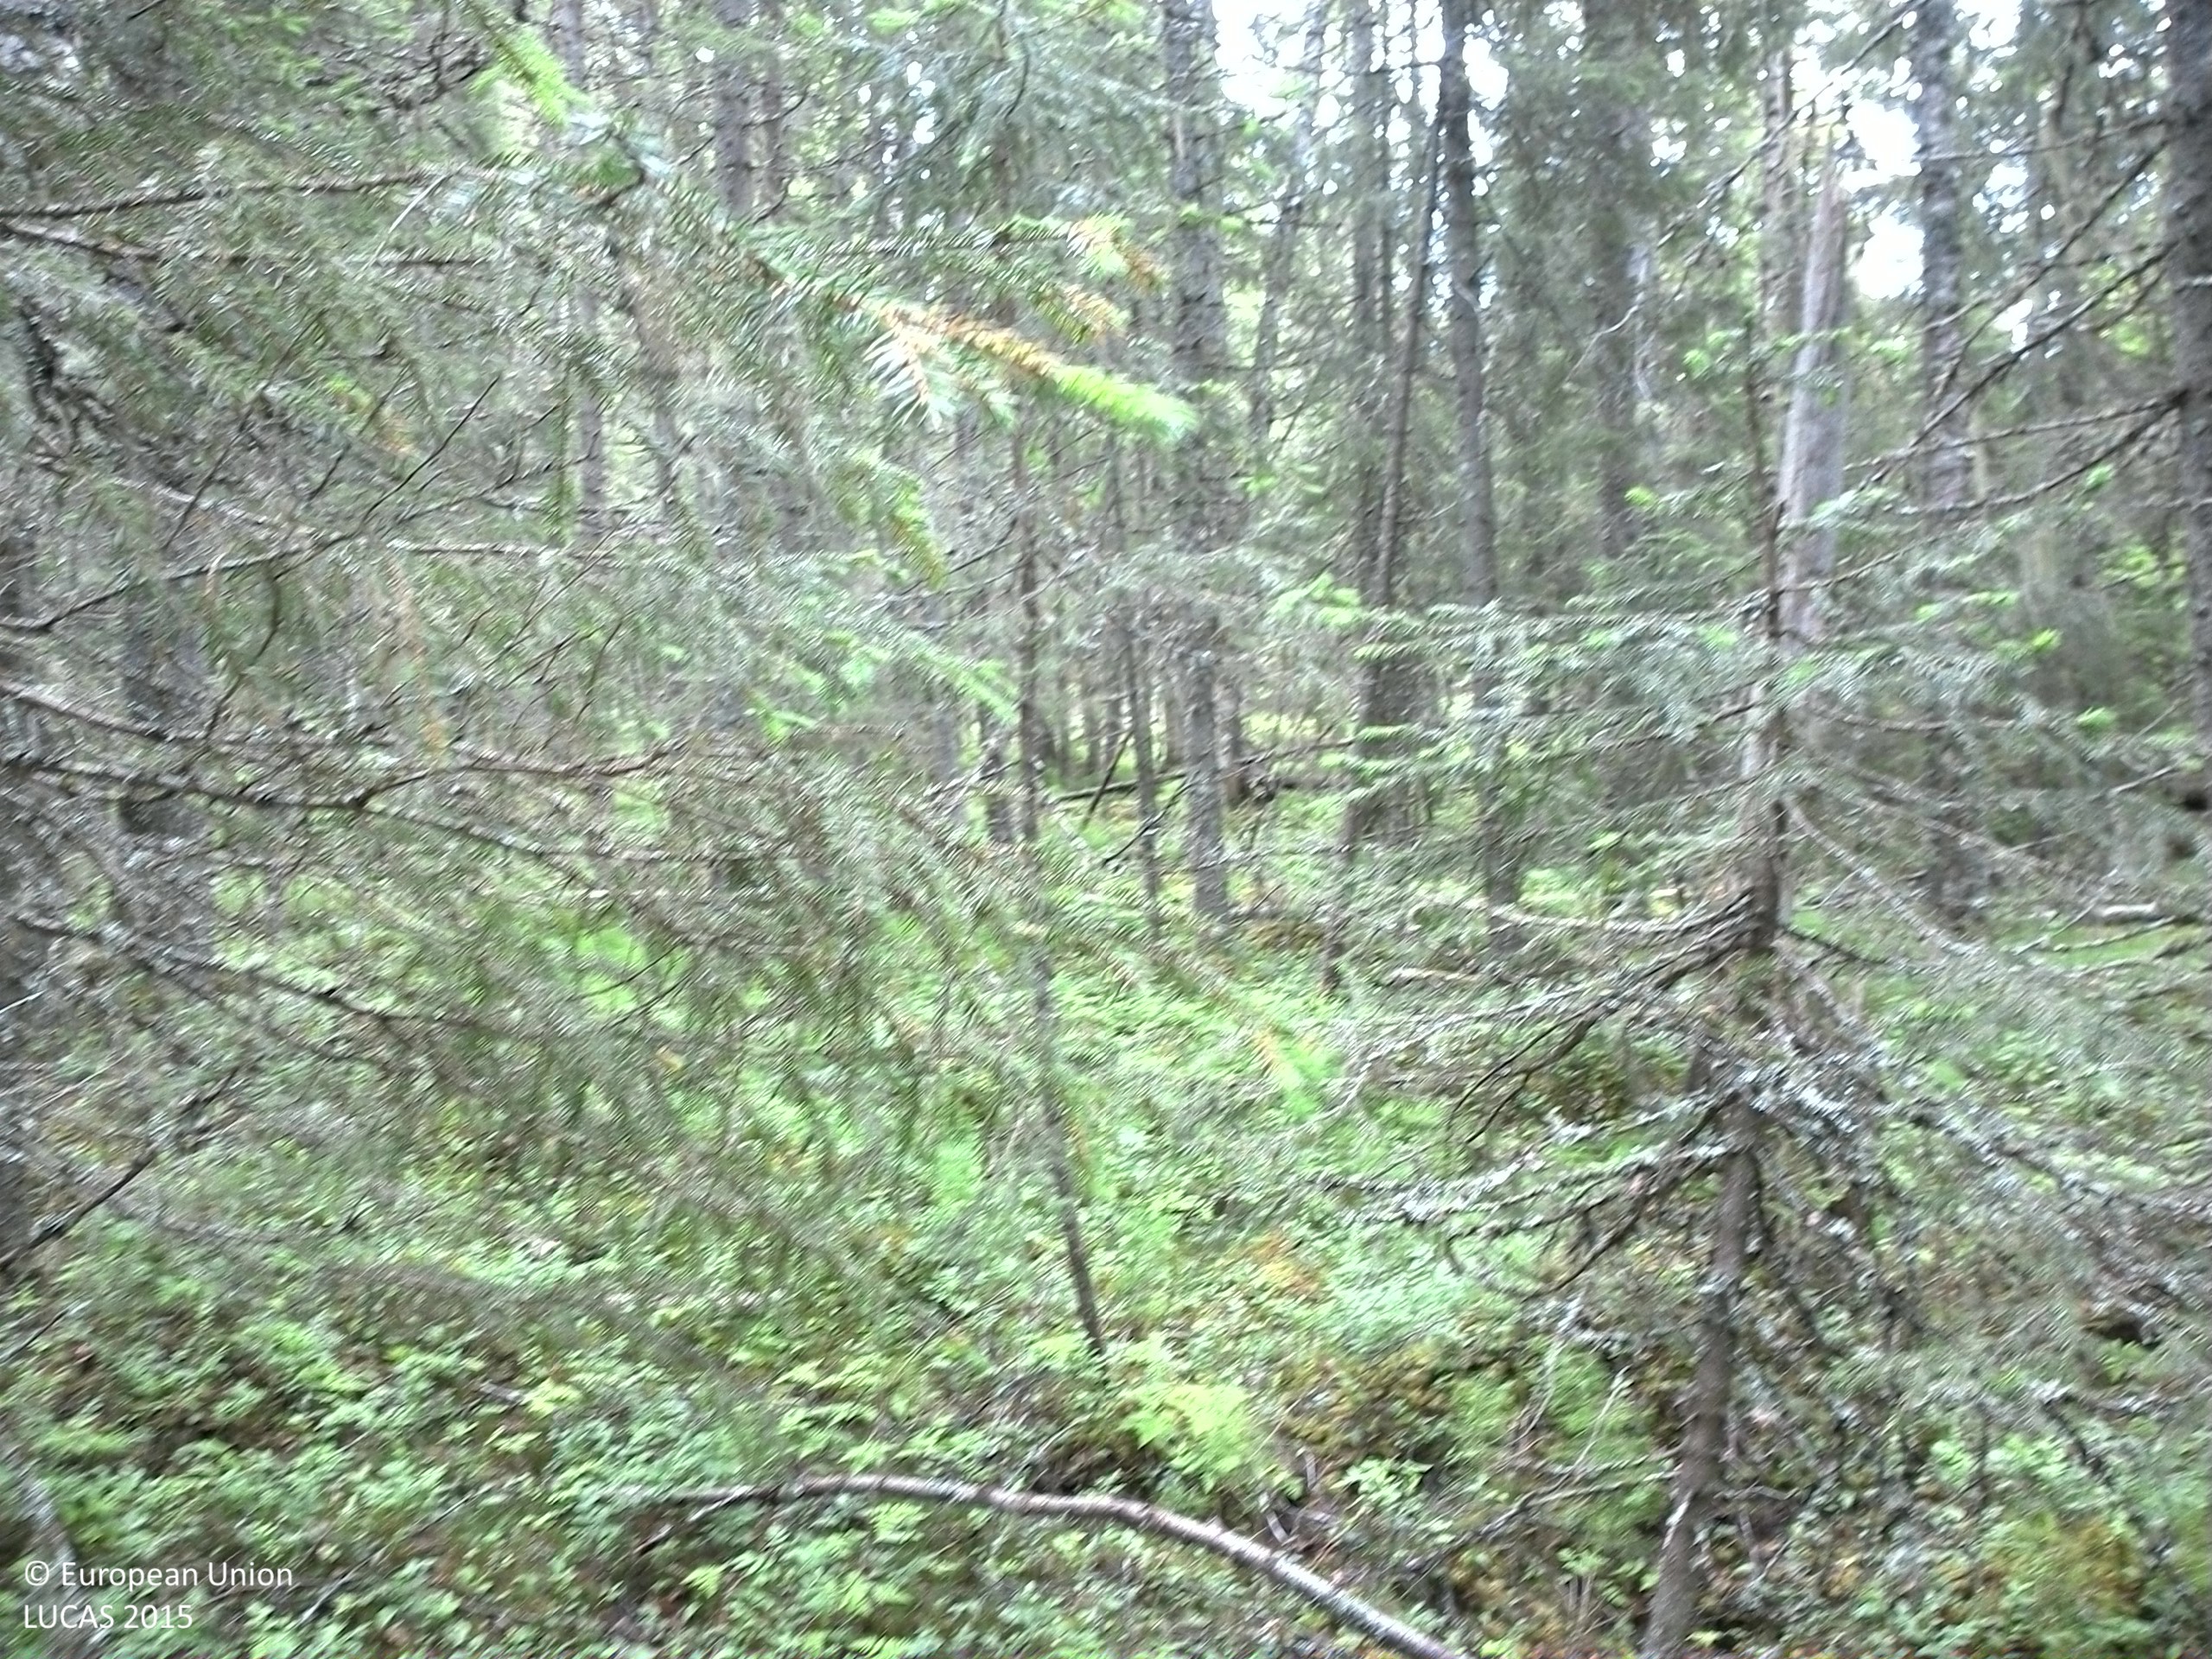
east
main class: Woodland
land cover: Spruce dominated coniferous woodland
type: boreal forest
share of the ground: > 75 %
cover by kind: coniferous forest trees 75 %, shrubs 15 %, broadleaved forest trees 5 %, herbaceous plants 5 %
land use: Forestry
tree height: > 5 m
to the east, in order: Spruce dominated coniferous woodland; Spruce dominated mixed woodland; Spruce dominated coniferous woodland
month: July
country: SE
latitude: 63.5529
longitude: 18.4885
